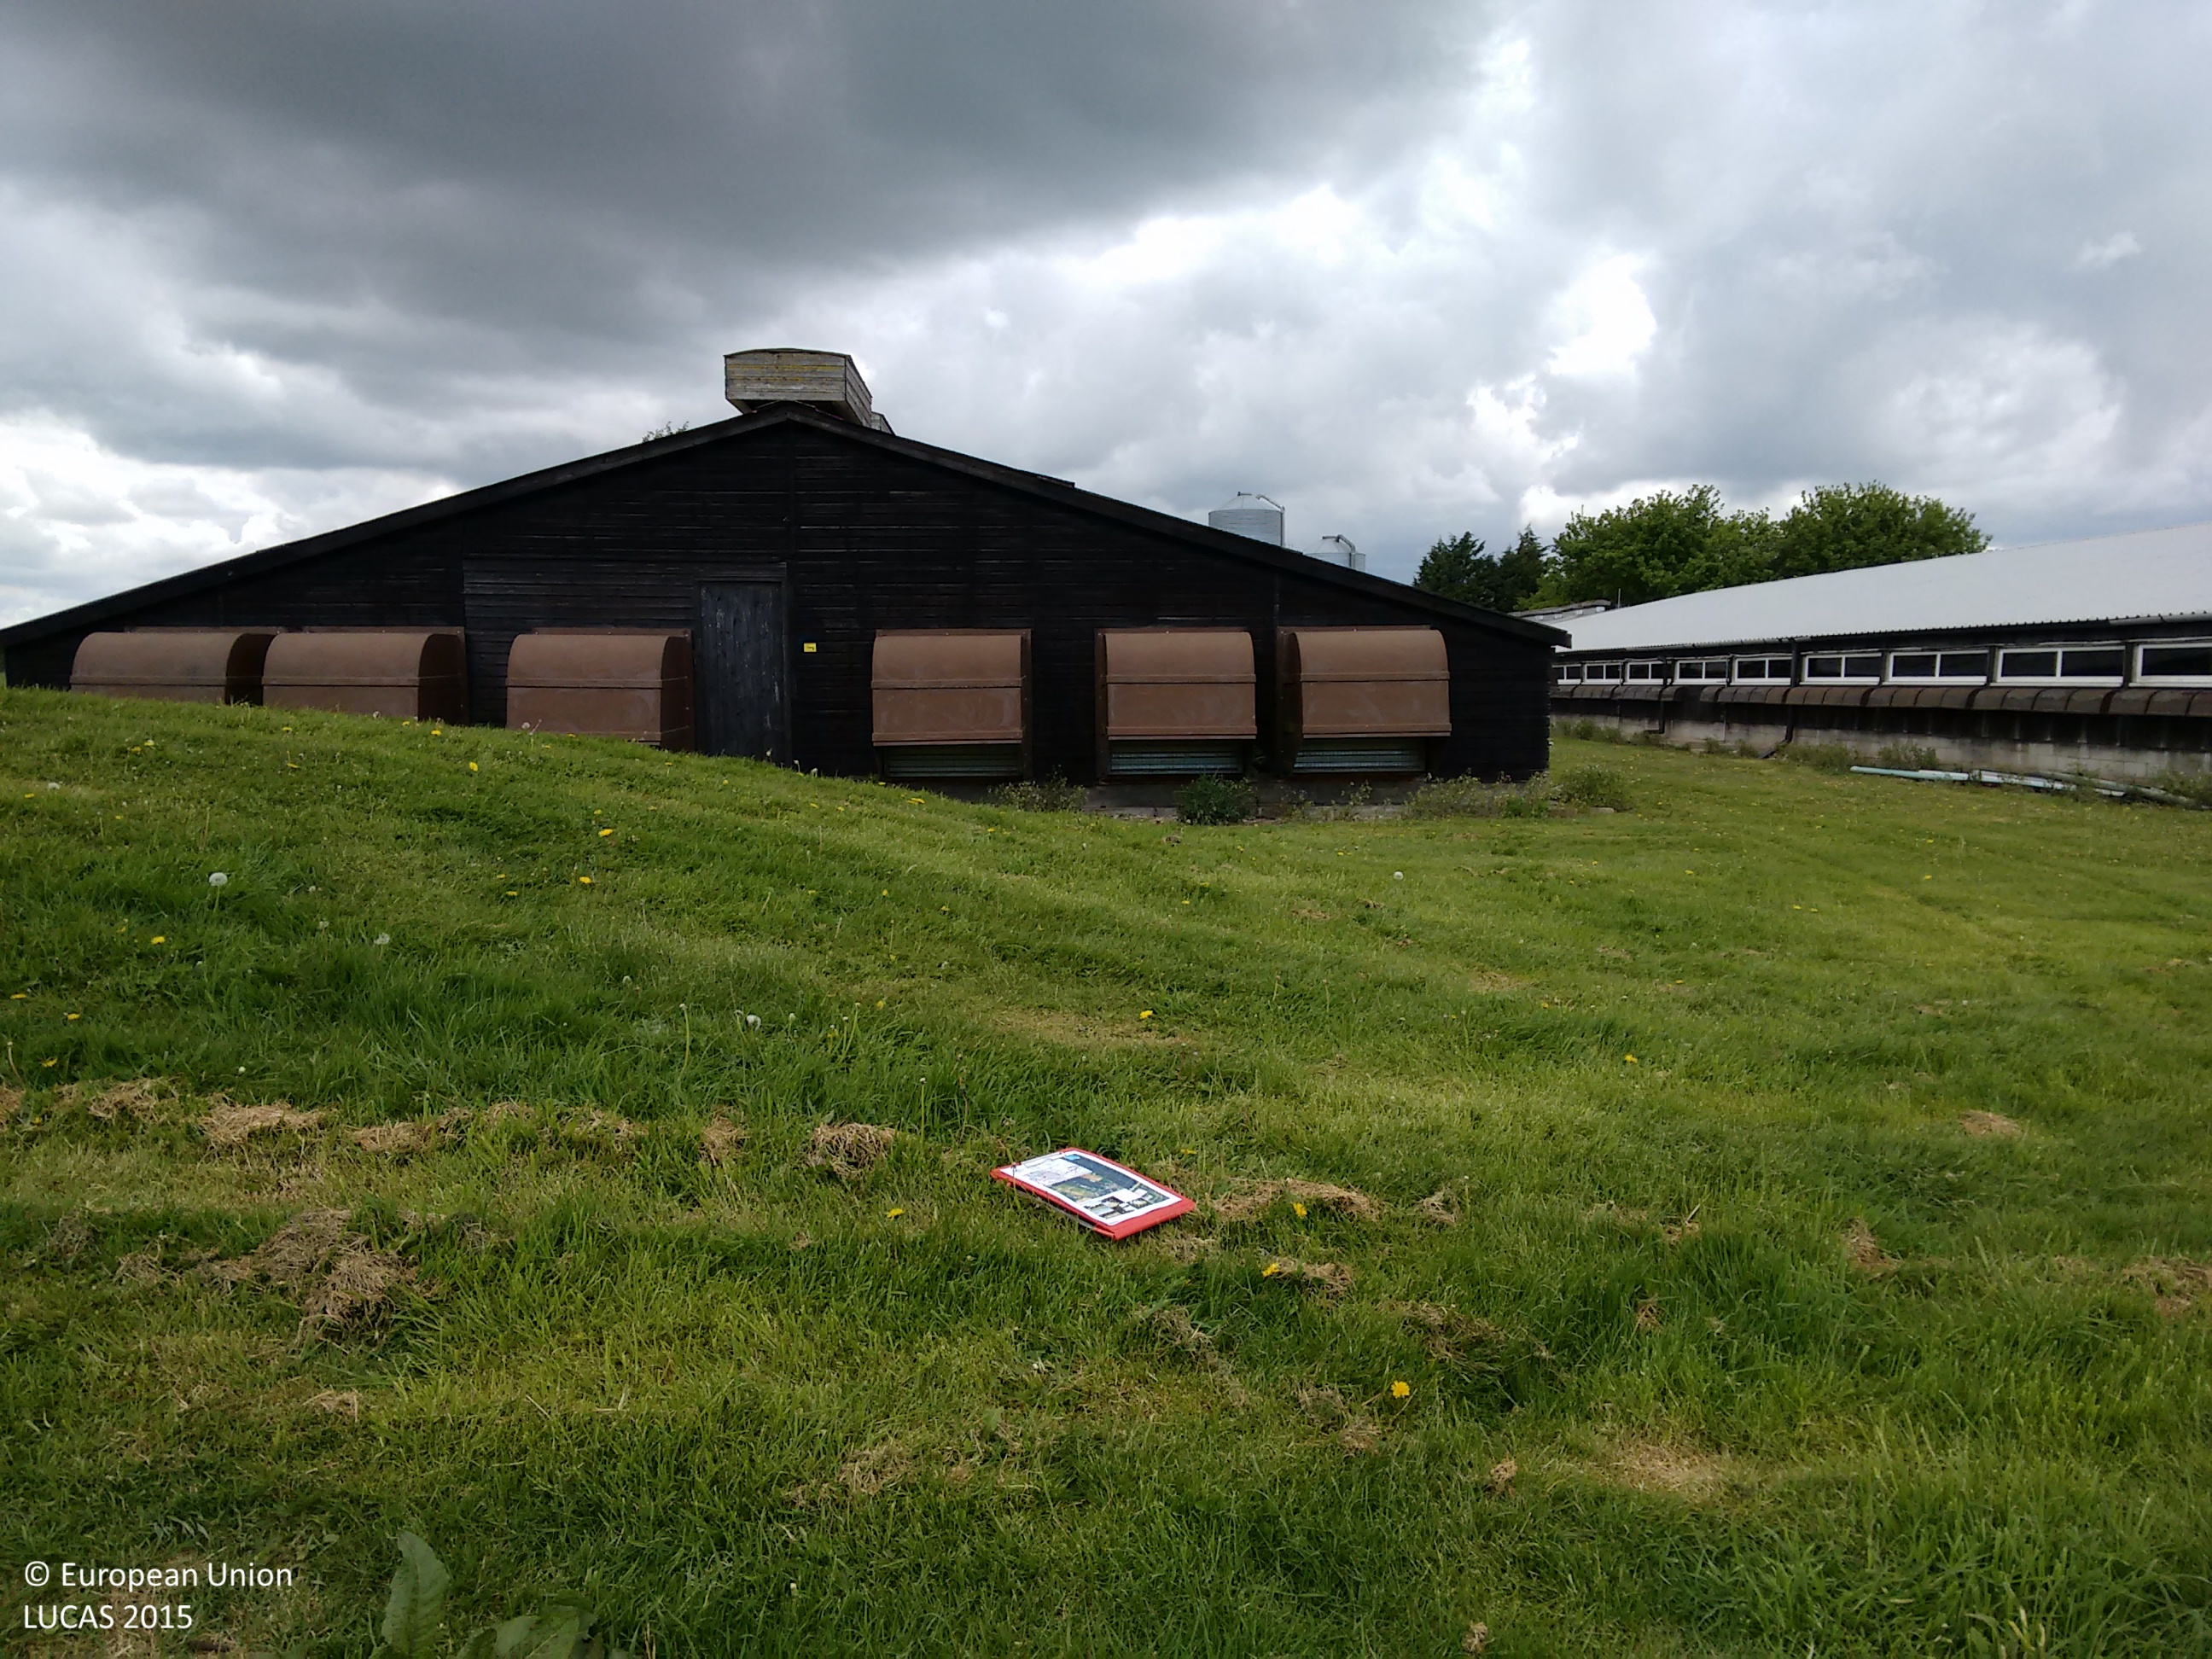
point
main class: Grassland
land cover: Grassland without tree/shrub cover
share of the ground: > 75 %
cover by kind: herbaceous plants 100 %
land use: Agriculture (excluding fallow land and kitchen gardens)
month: May
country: GB
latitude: 53.3860
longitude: -0.2129
